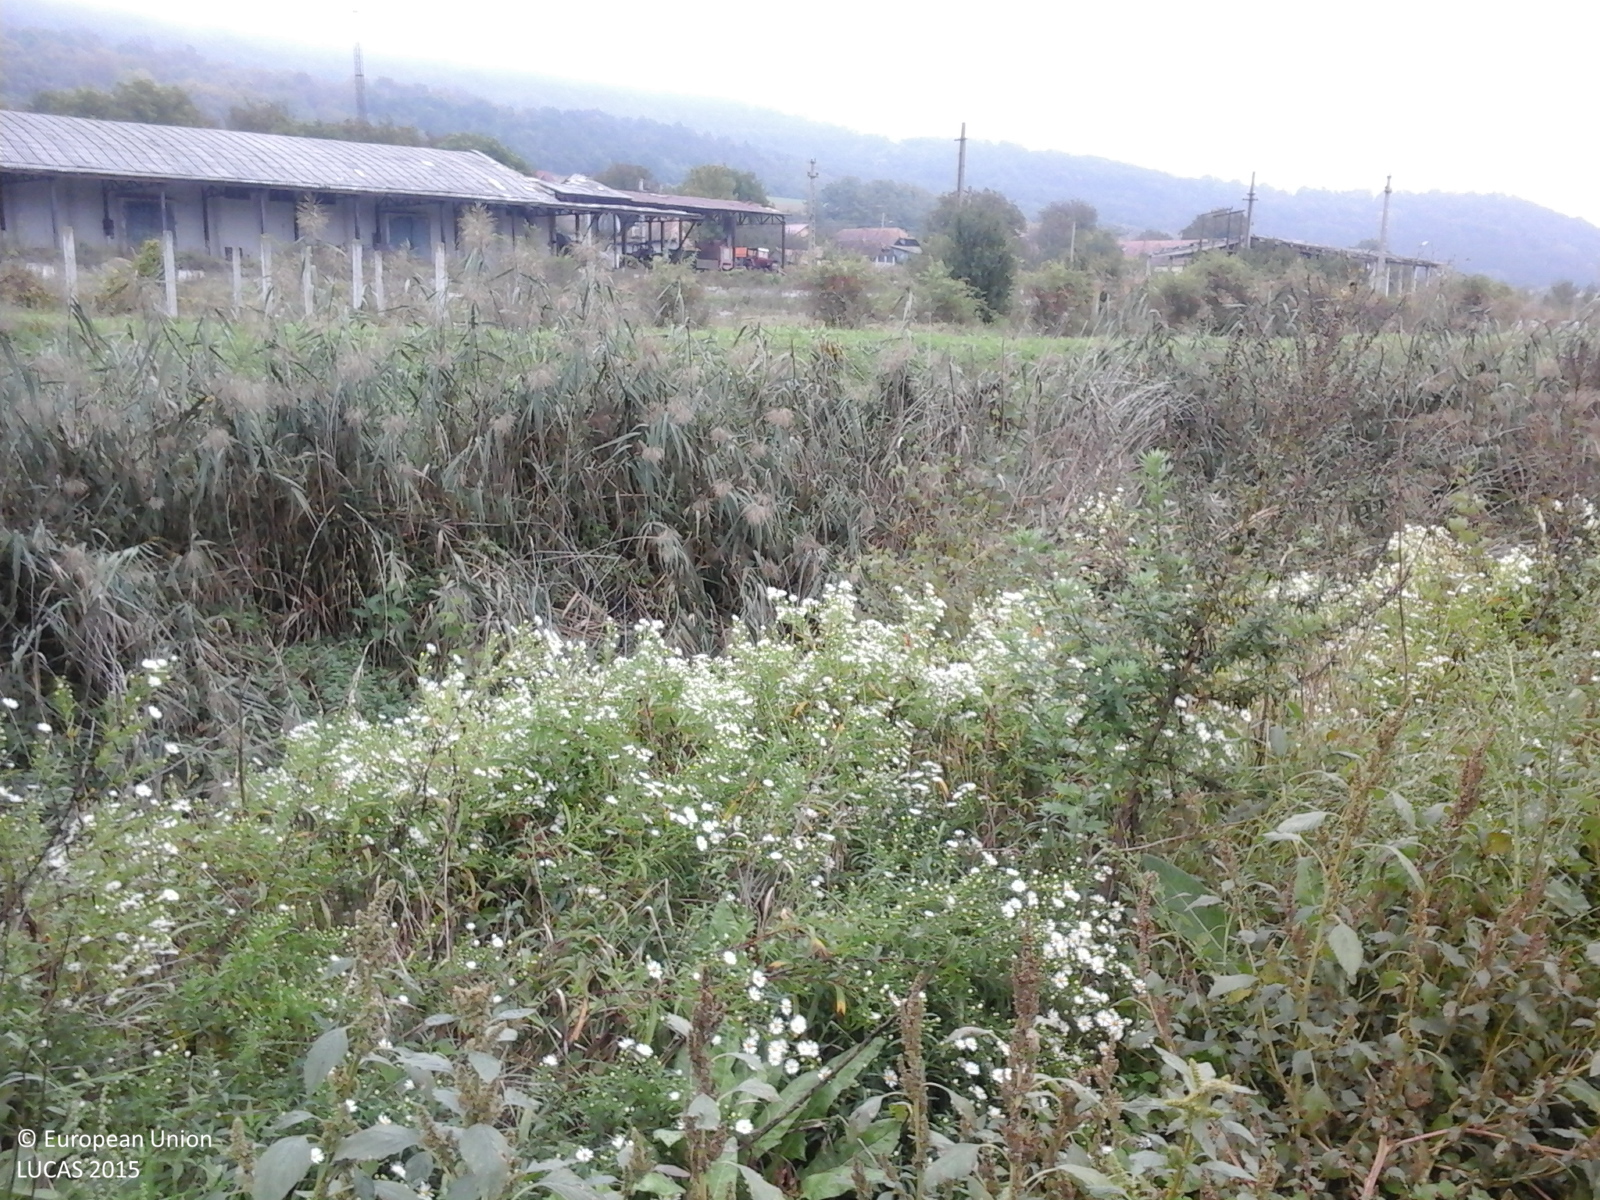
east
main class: Cropland
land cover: Maize
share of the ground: > 75 %
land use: Agriculture (excluding fallow land and kitchen gardens)
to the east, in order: Maize; Other fruit trees and berries; Vineyards; Grass margins; Other fruit trees and berries; Fences; Grass margins; Tracks; Spontaneously vegetated surfaces; Ditches and canals; Spontaneously vegetated surfaces; Artificial constructions in urban areas
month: October
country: RO
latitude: 46.6865
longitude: 24.4032
